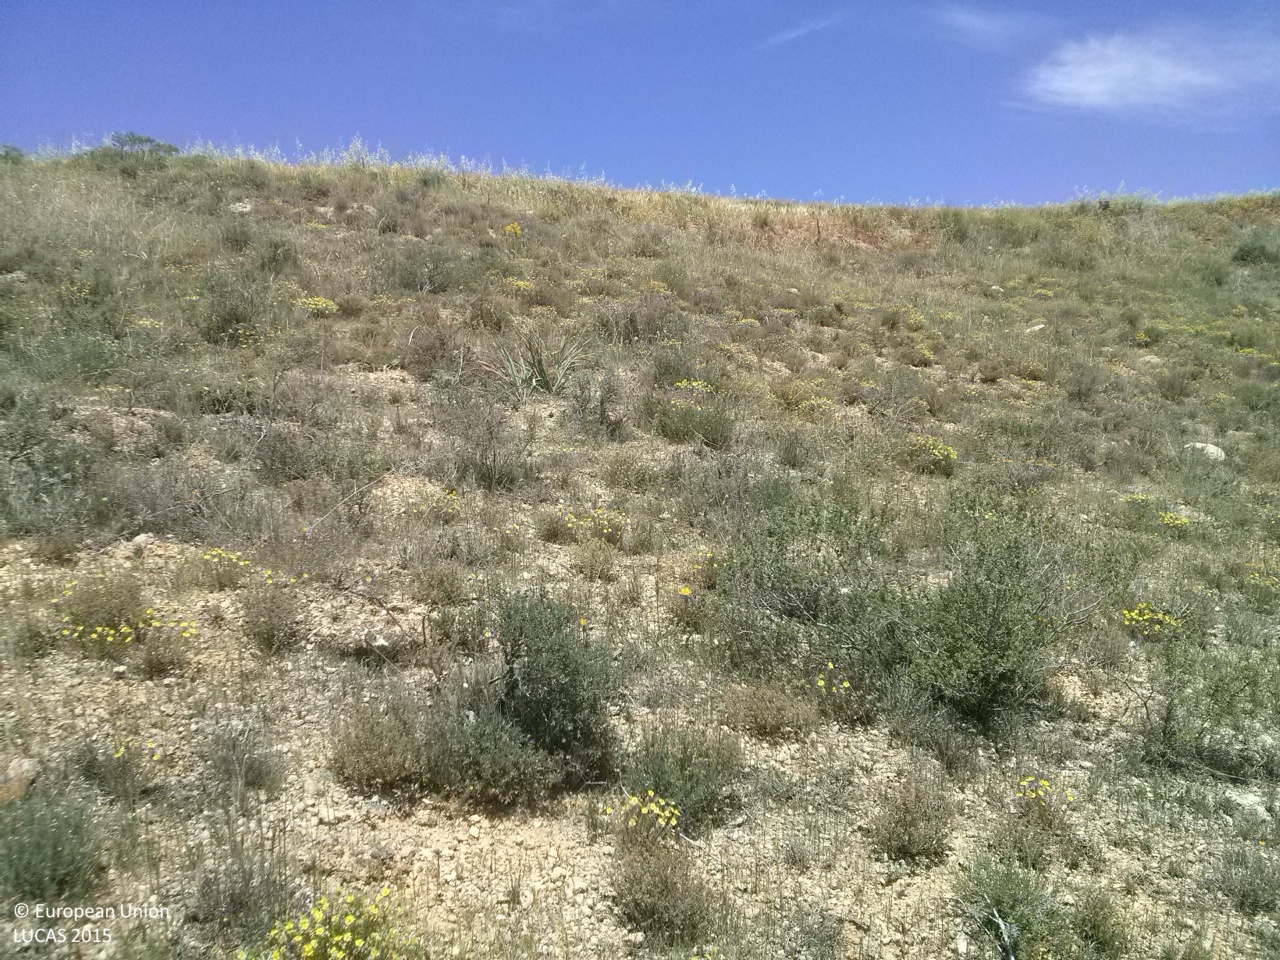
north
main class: Shrubland
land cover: Shrubland without tree cover
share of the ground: 50 - 75 %
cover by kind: shrubs 40 %, herbaceous plants 30 %, unconsolidated bare surface 30 %
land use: Semi-natural and natural areas not in use
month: May
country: ES
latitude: 40.0845
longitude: -2.7939
